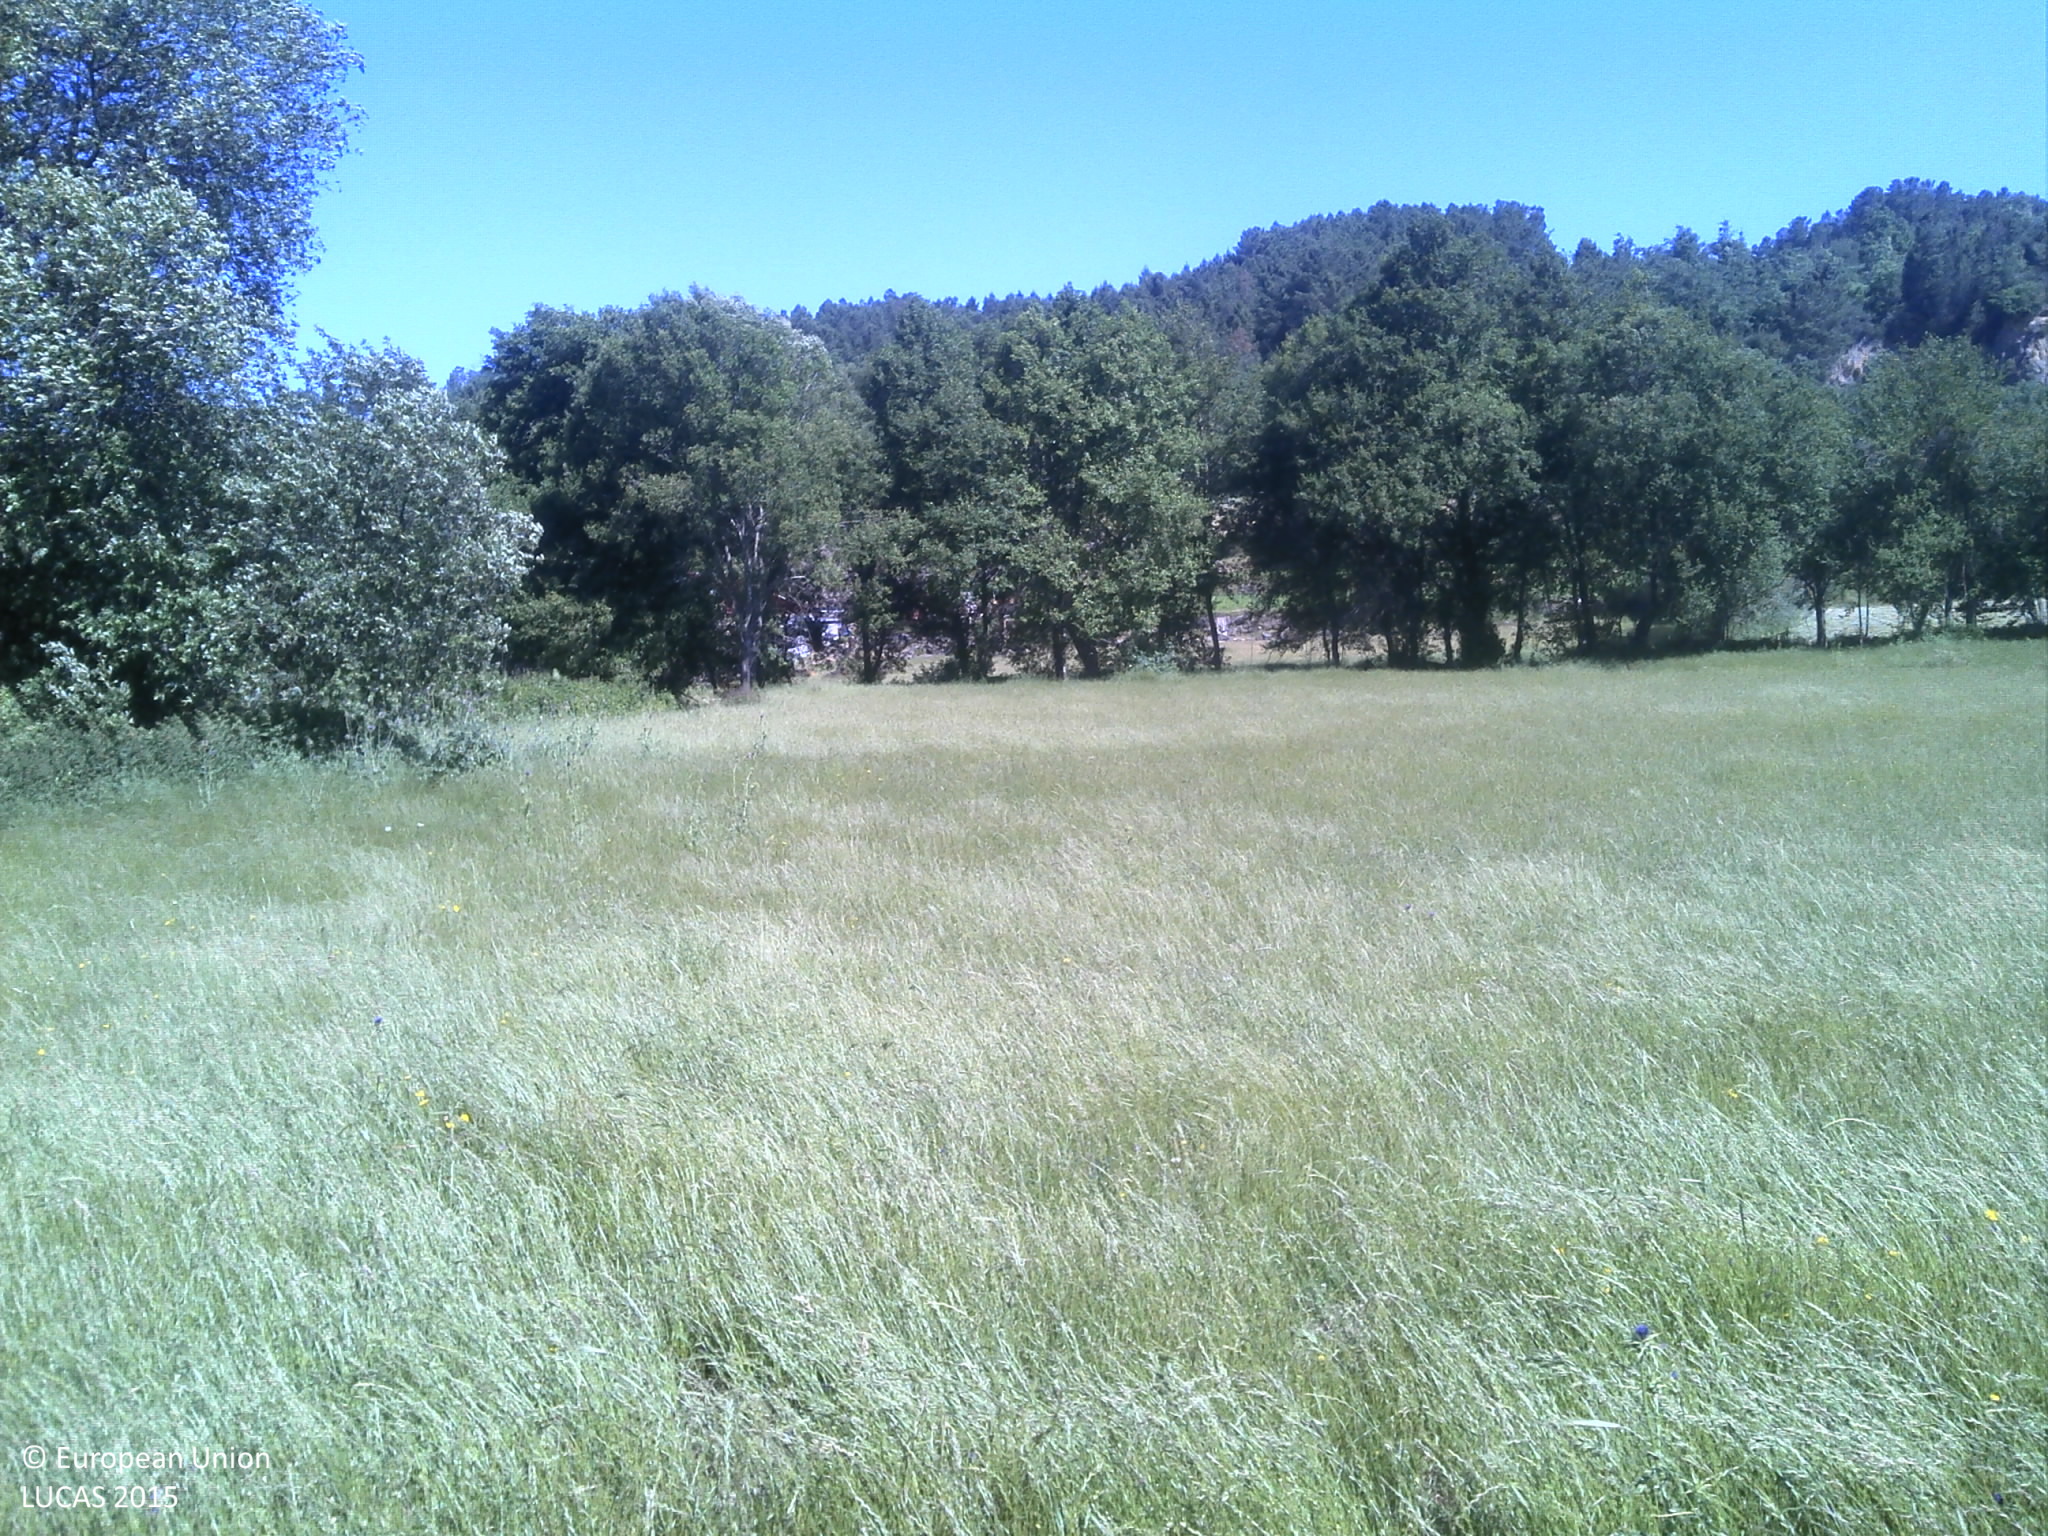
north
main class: Grassland
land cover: Grassland without tree/shrub cover
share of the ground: > 75 %
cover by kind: herbaceous plants 90 %, unconsolidated bare surface 10 %
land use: Agriculture (excluding fallow land and kitchen gardens)
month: May
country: PT
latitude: 40.4319
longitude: -7.7146
